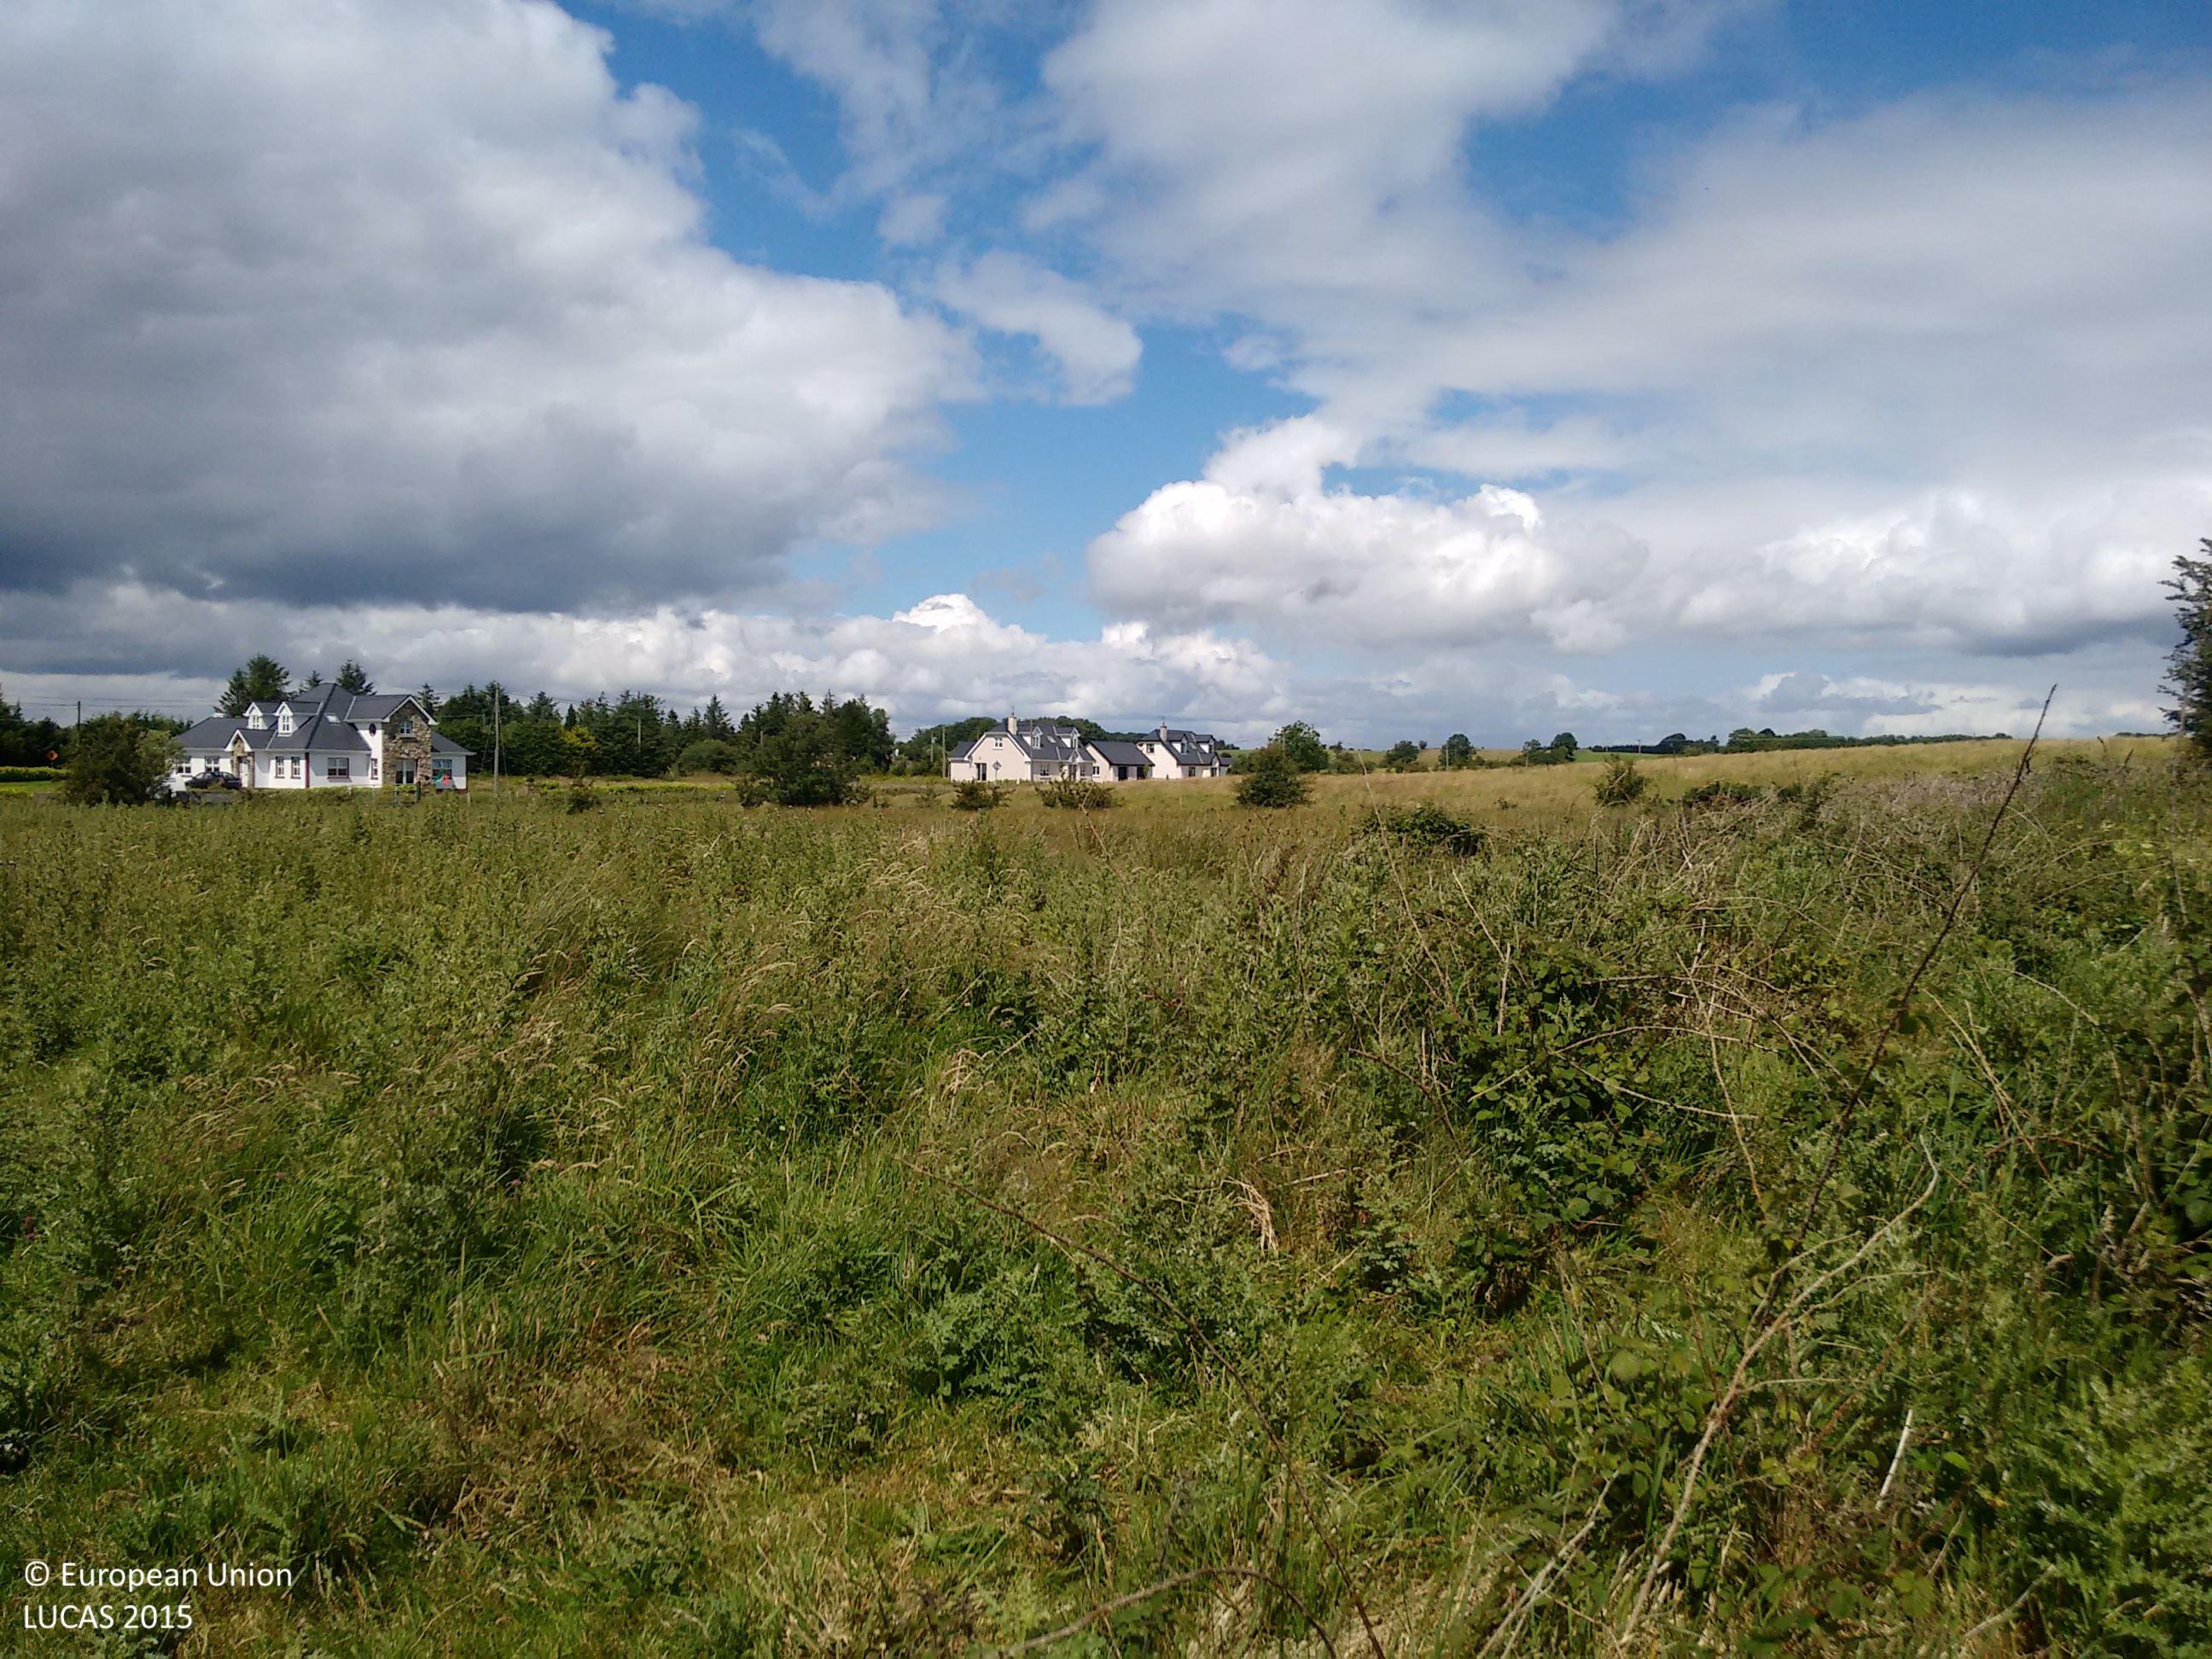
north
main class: Grassland
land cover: Grassland with sparse tree/shrub cover
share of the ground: 50 - 75 %
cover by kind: herbaceous plants 85 %, shrubs 10 %, broadleaved forest trees 5 %
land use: Agriculture (excluding fallow land and kitchen gardens)
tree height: < 5 m
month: July
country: IE
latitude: 53.6925
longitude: -8.7541
